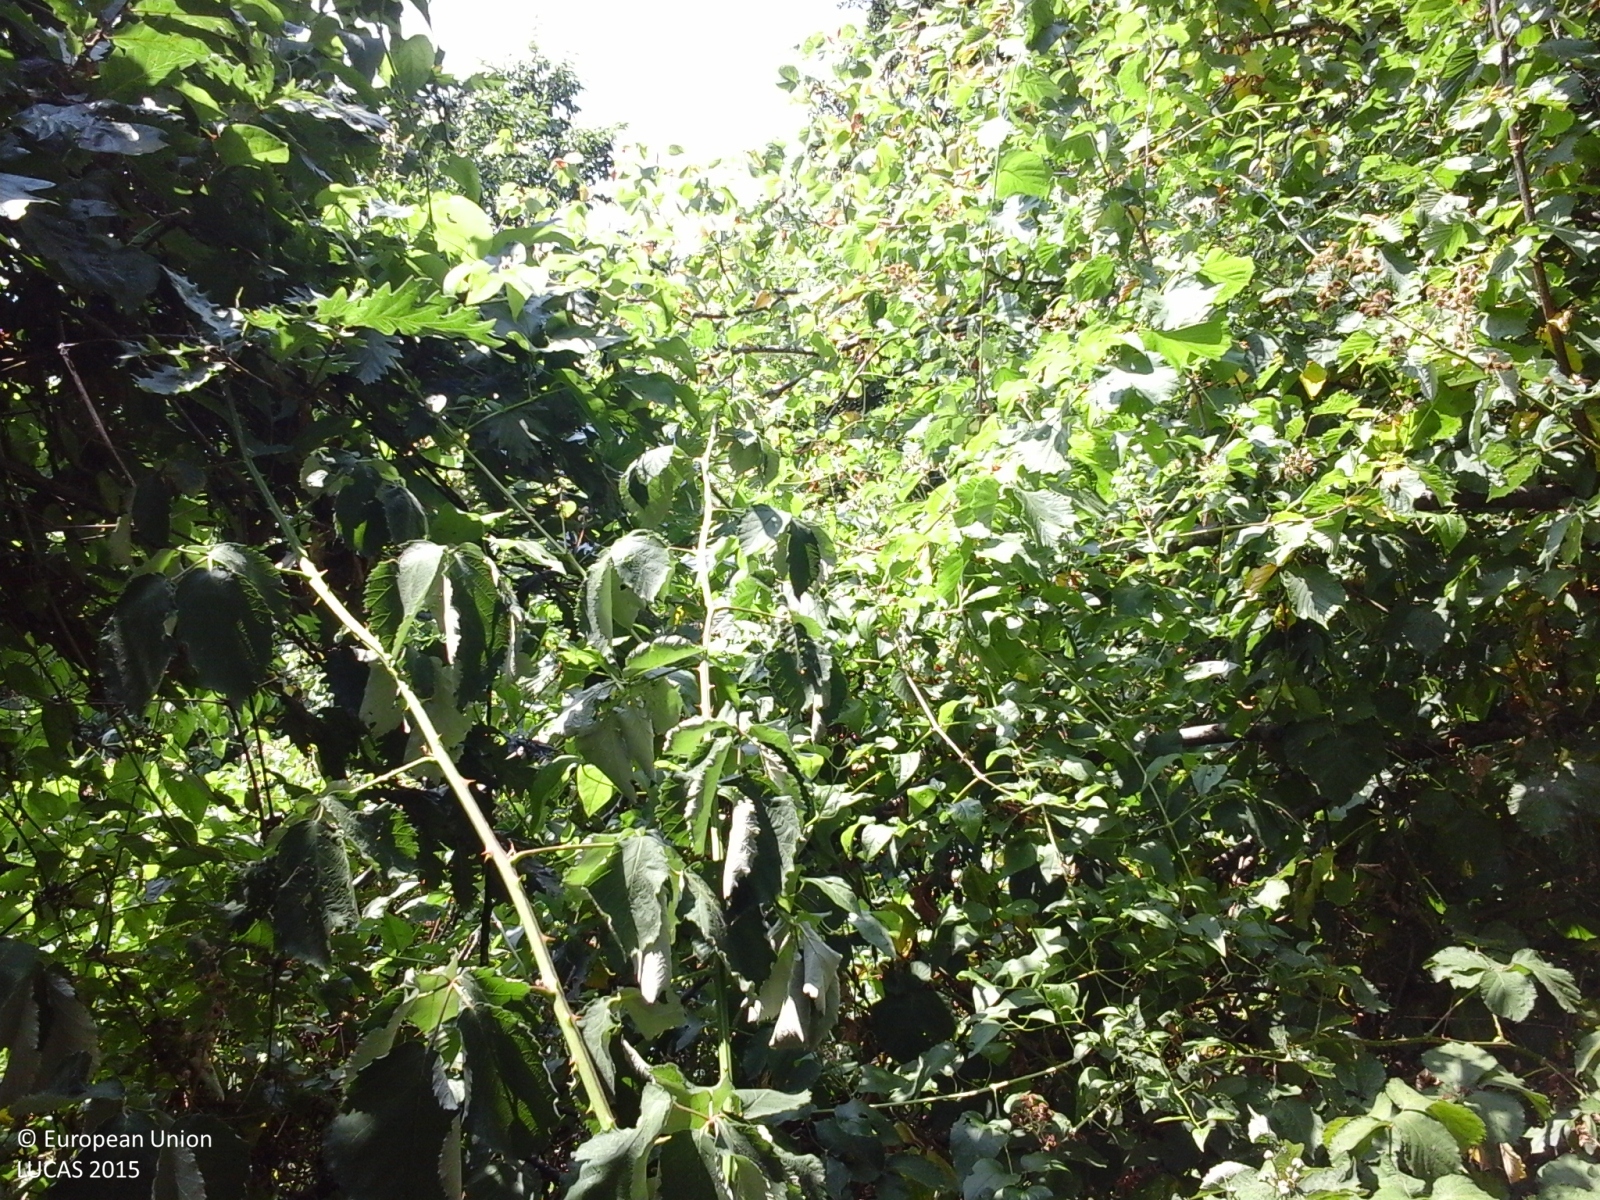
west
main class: Woodland
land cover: Broadleaved woodland
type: thermophilous deciduous forest
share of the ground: > 75 %
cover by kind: broadleaved forest trees 100 %
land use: Forestry
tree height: > 5 m
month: July
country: IT
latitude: 45.5884
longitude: 11.1389
